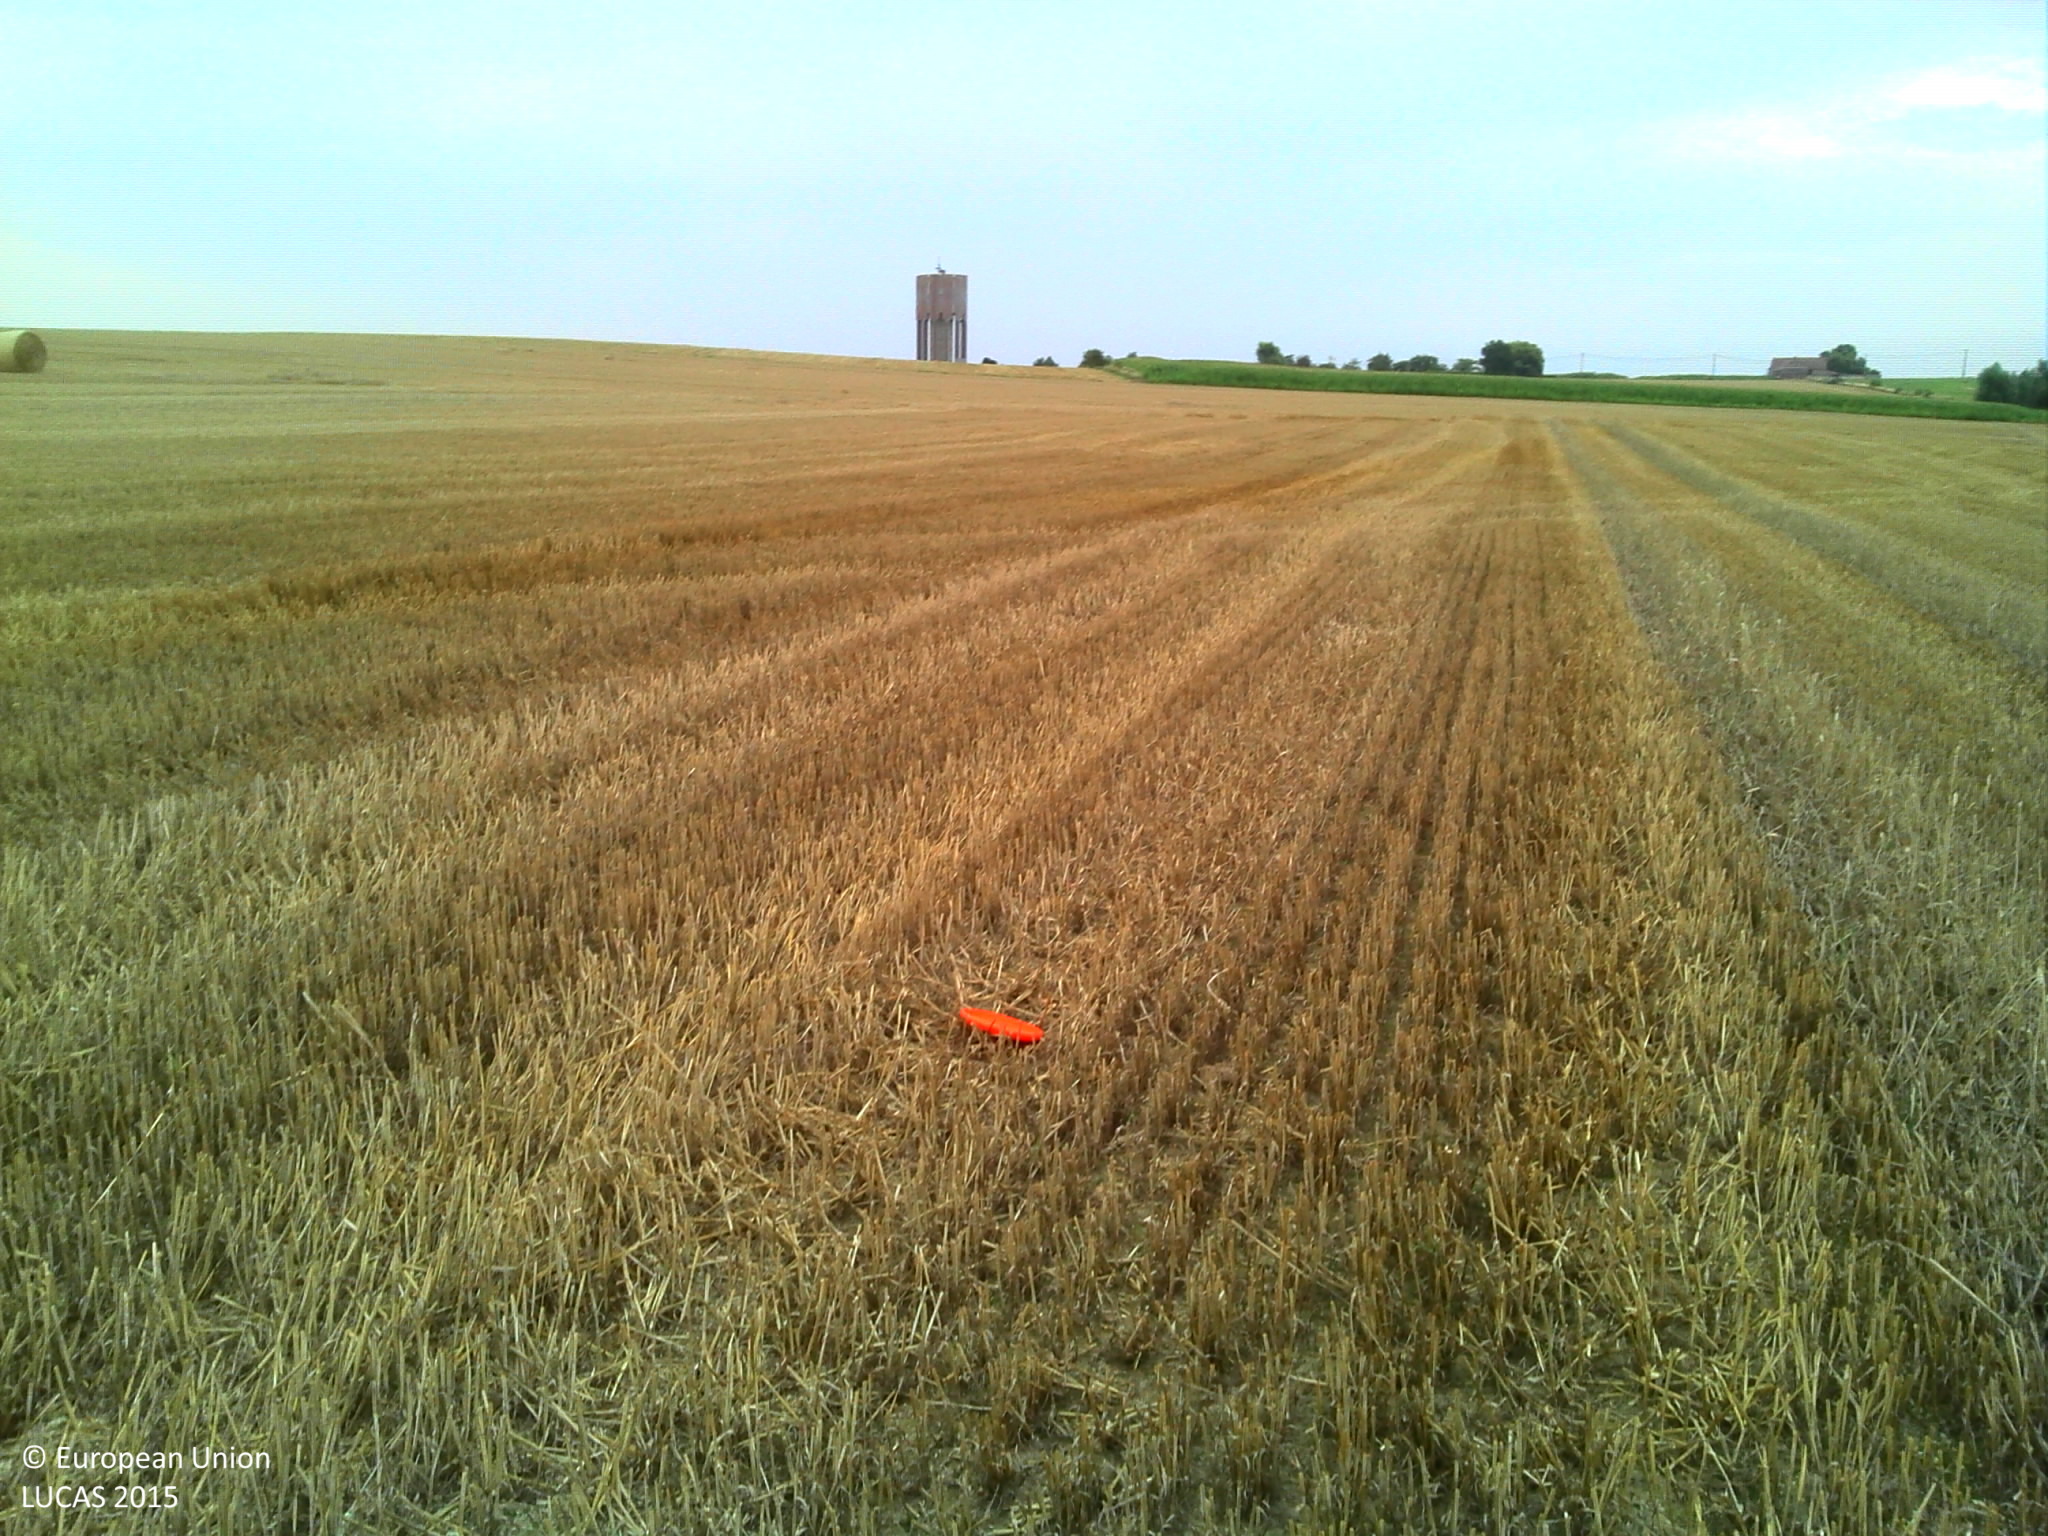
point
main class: Cropland
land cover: Common wheat
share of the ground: < 10 %
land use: Agriculture (excluding fallow land and kitchen gardens)
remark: Harvested field
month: August
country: BE
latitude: 50.6623
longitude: 3.7544
